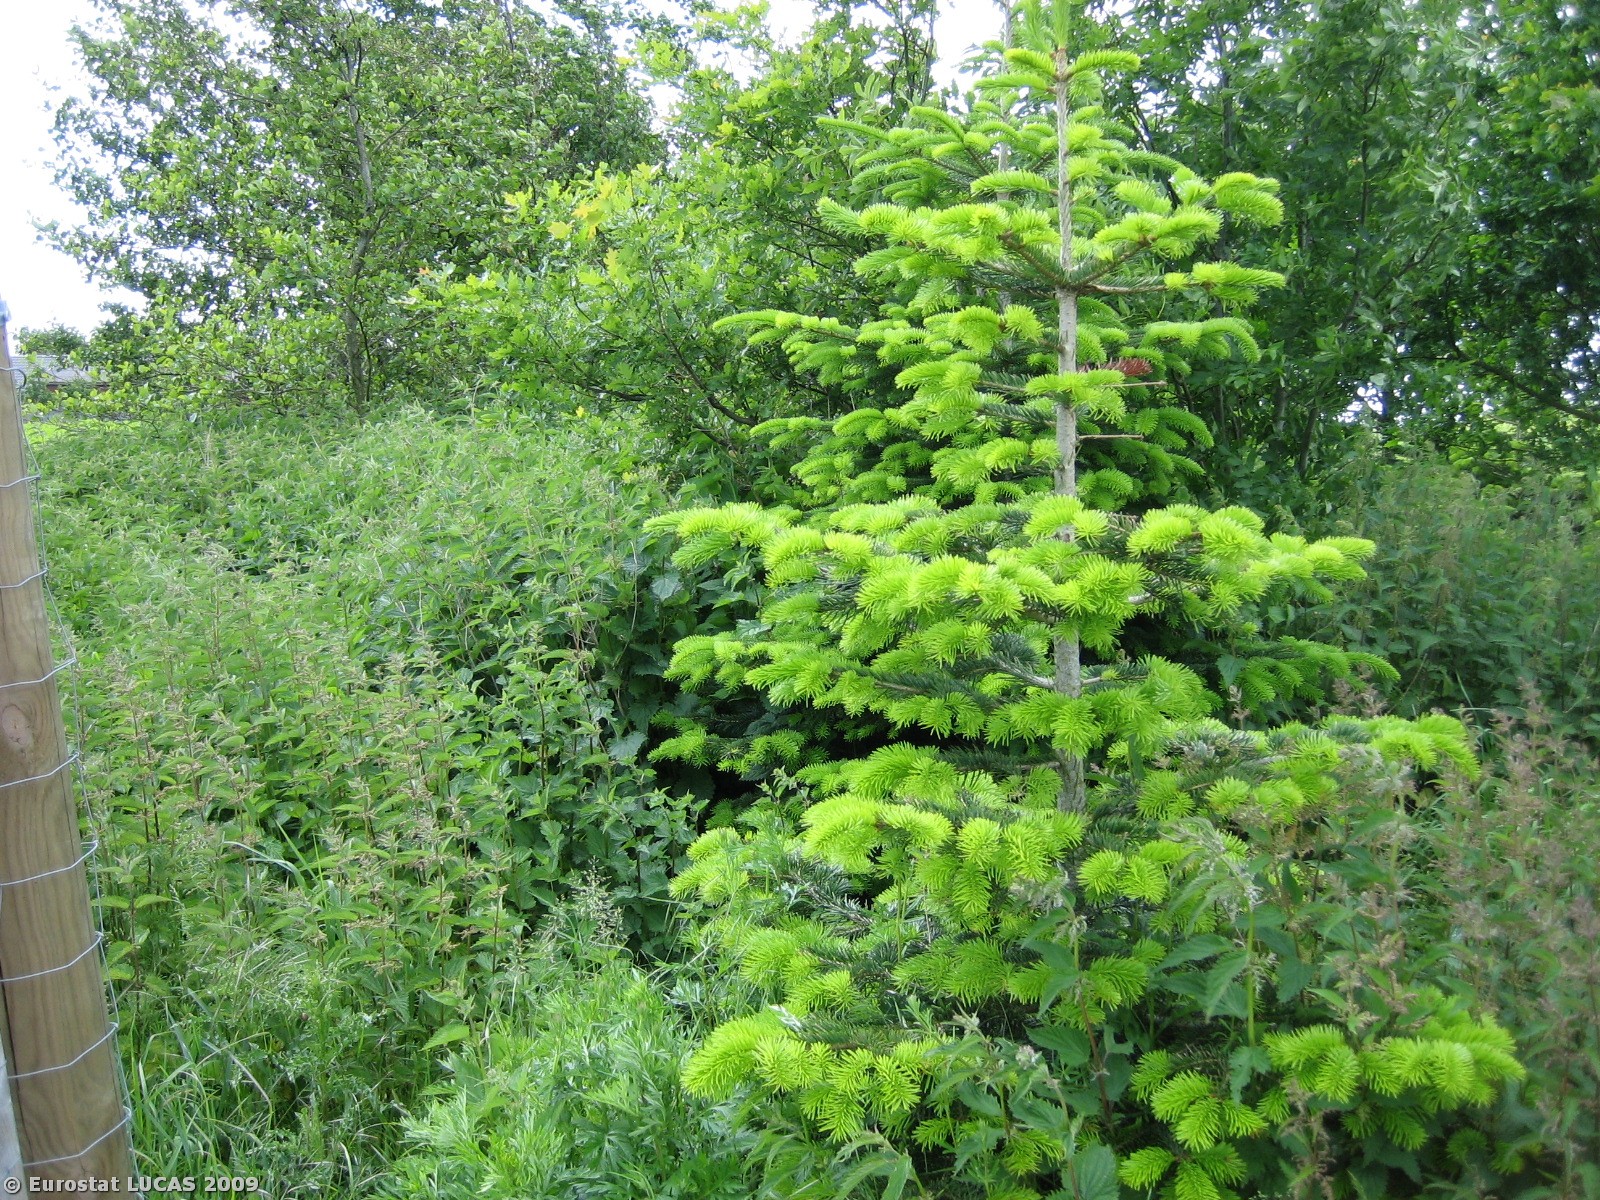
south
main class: Woodland
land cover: Coniferous woodland
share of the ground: 10 - 25 %
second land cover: Bare land
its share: > 75 %
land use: Agriculture (excluding fallow land and kitchen gardens)
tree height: < 5 m
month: June
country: DK
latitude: 55.8638
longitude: 9.6967
